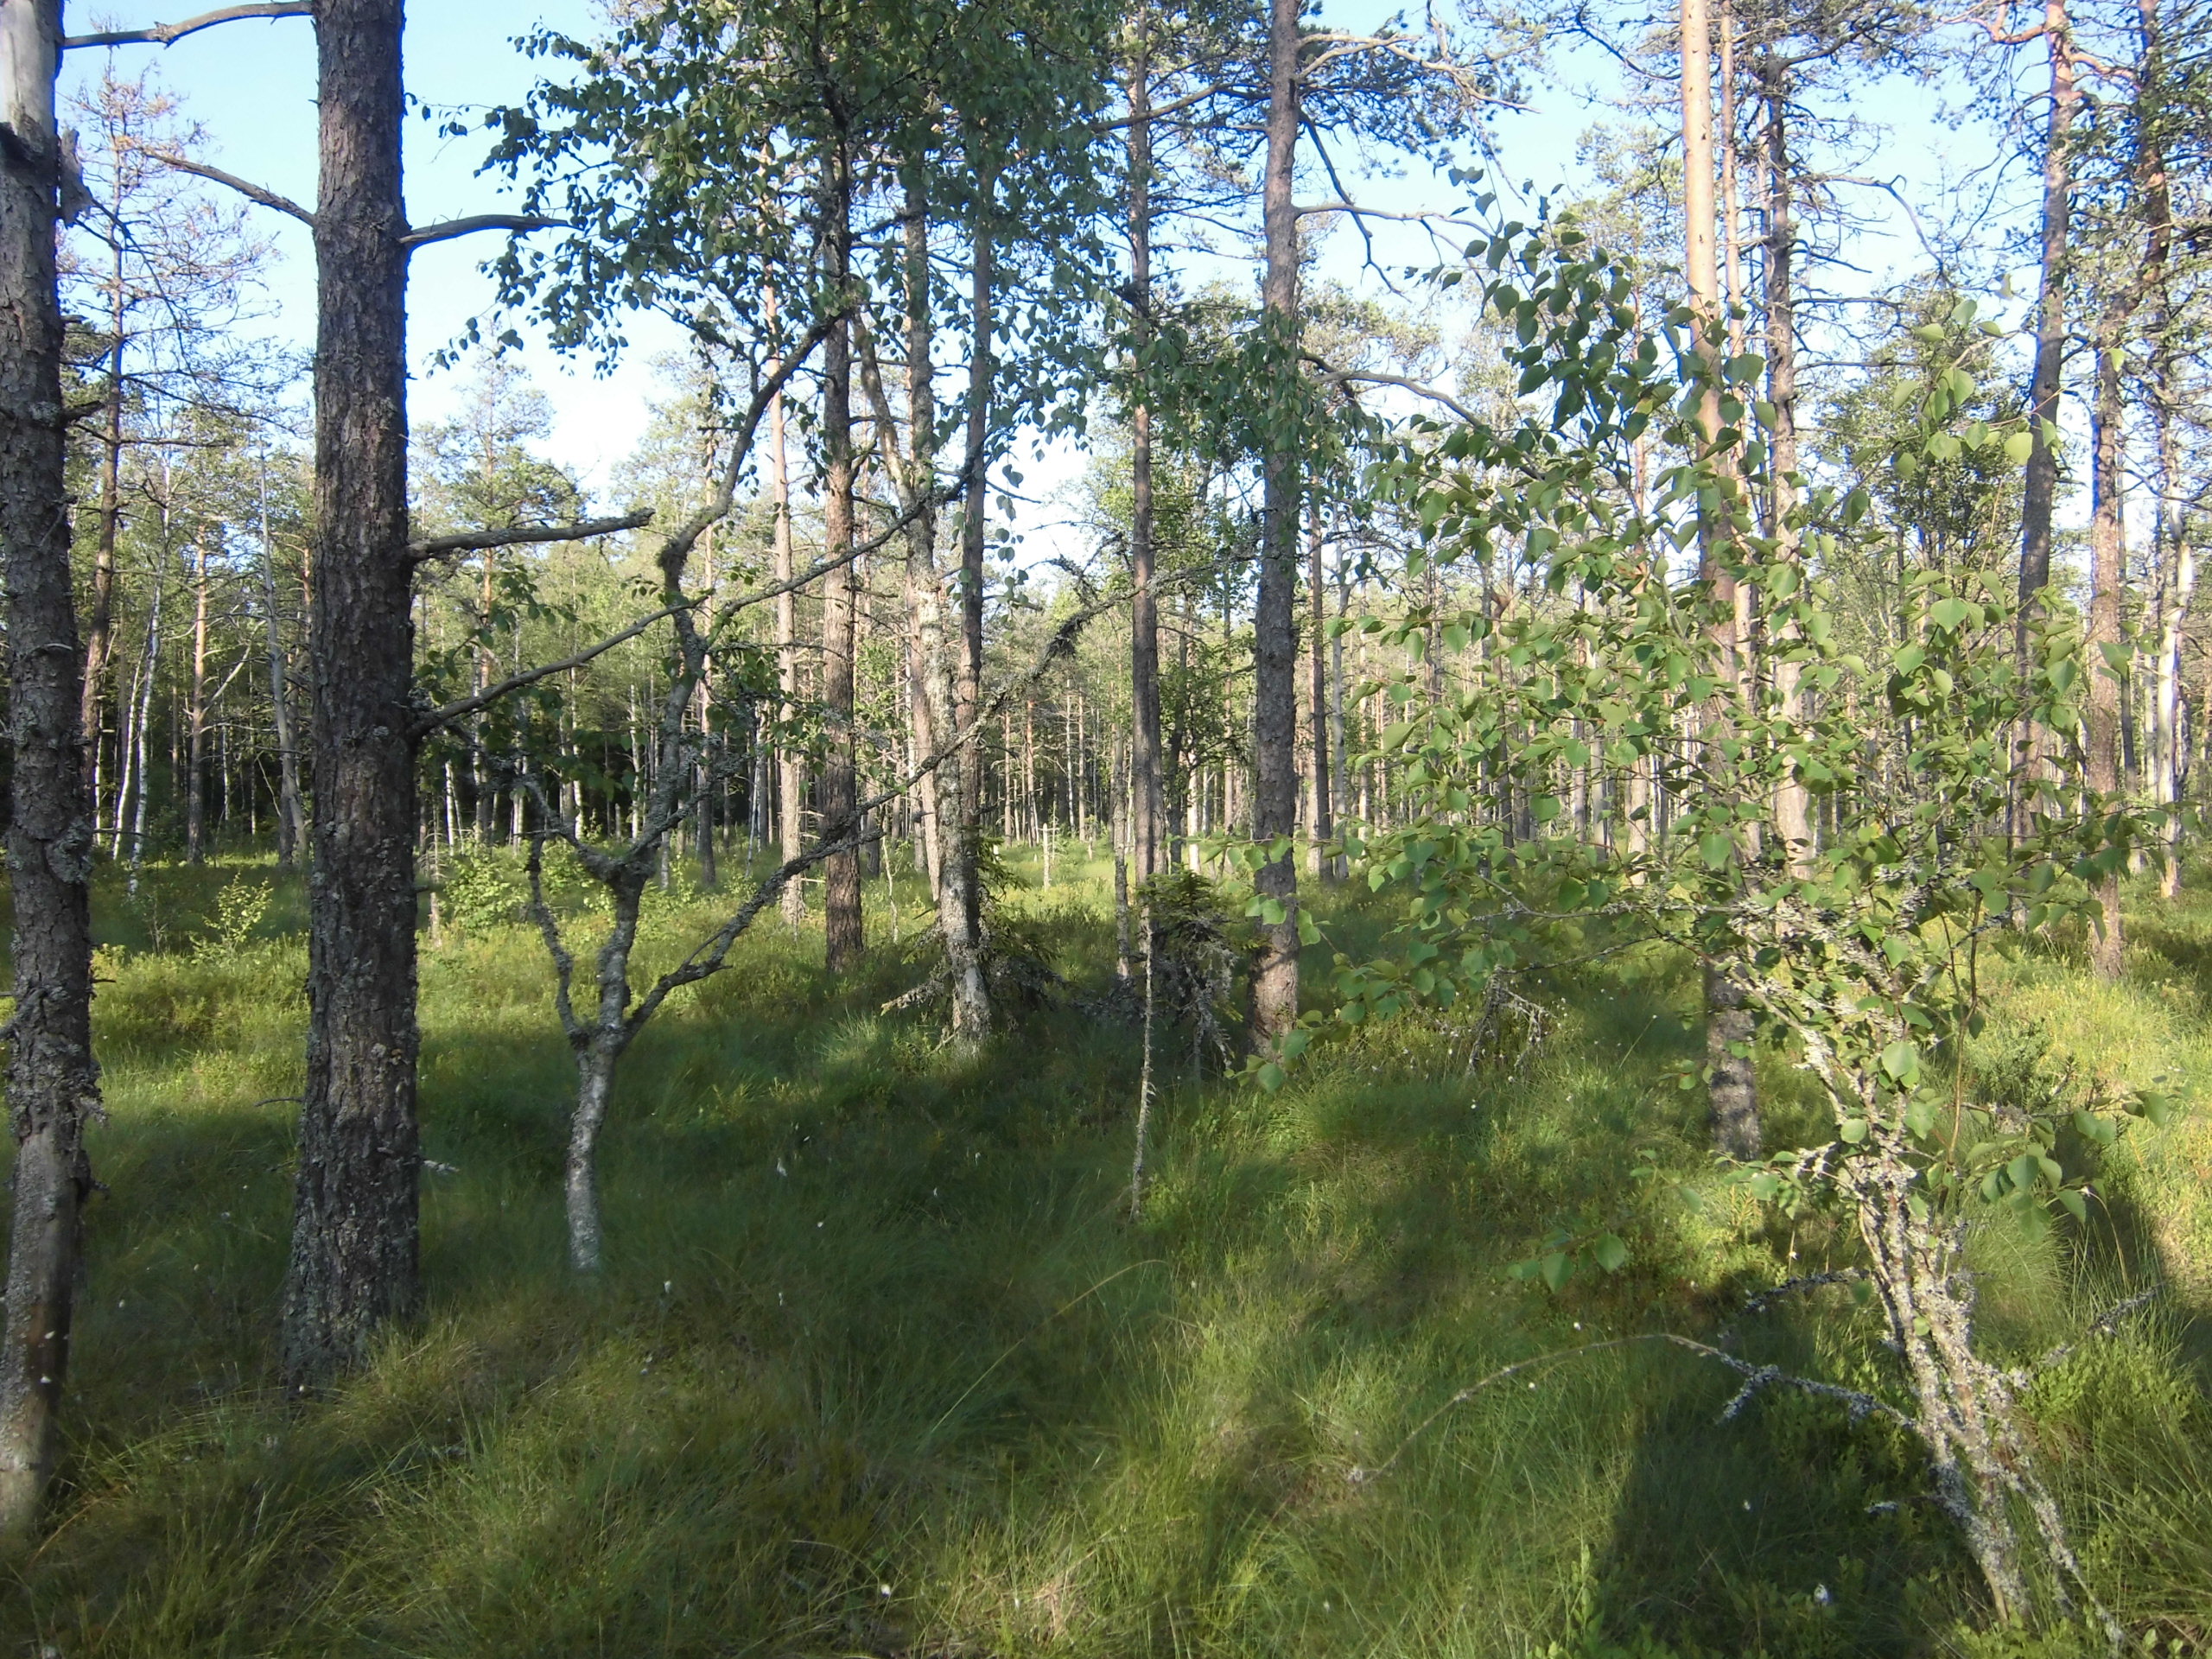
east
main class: Woodland
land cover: Pine dominated coniferous woodland
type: boreal forest
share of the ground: 50 - 75 %
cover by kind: coniferous forest trees 50 %, shrubs 15 %, herbaceous plants 15 %, lichens and mosses 15 %, broadleaved forest trees 5 %
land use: Forestry
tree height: > 5 m
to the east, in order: Pine dominated coniferous woodland; Spruce dominated coniferous woodland; Ditches and canals; Tracks; Spruce dominated coniferous woodland; Broadleaved woodland; Tracks; Grassland with sparse tree/shrub cover; Paved roads, cycling and walking lanes; Barley
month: July
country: SE
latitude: 57.1800
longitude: 15.2411
